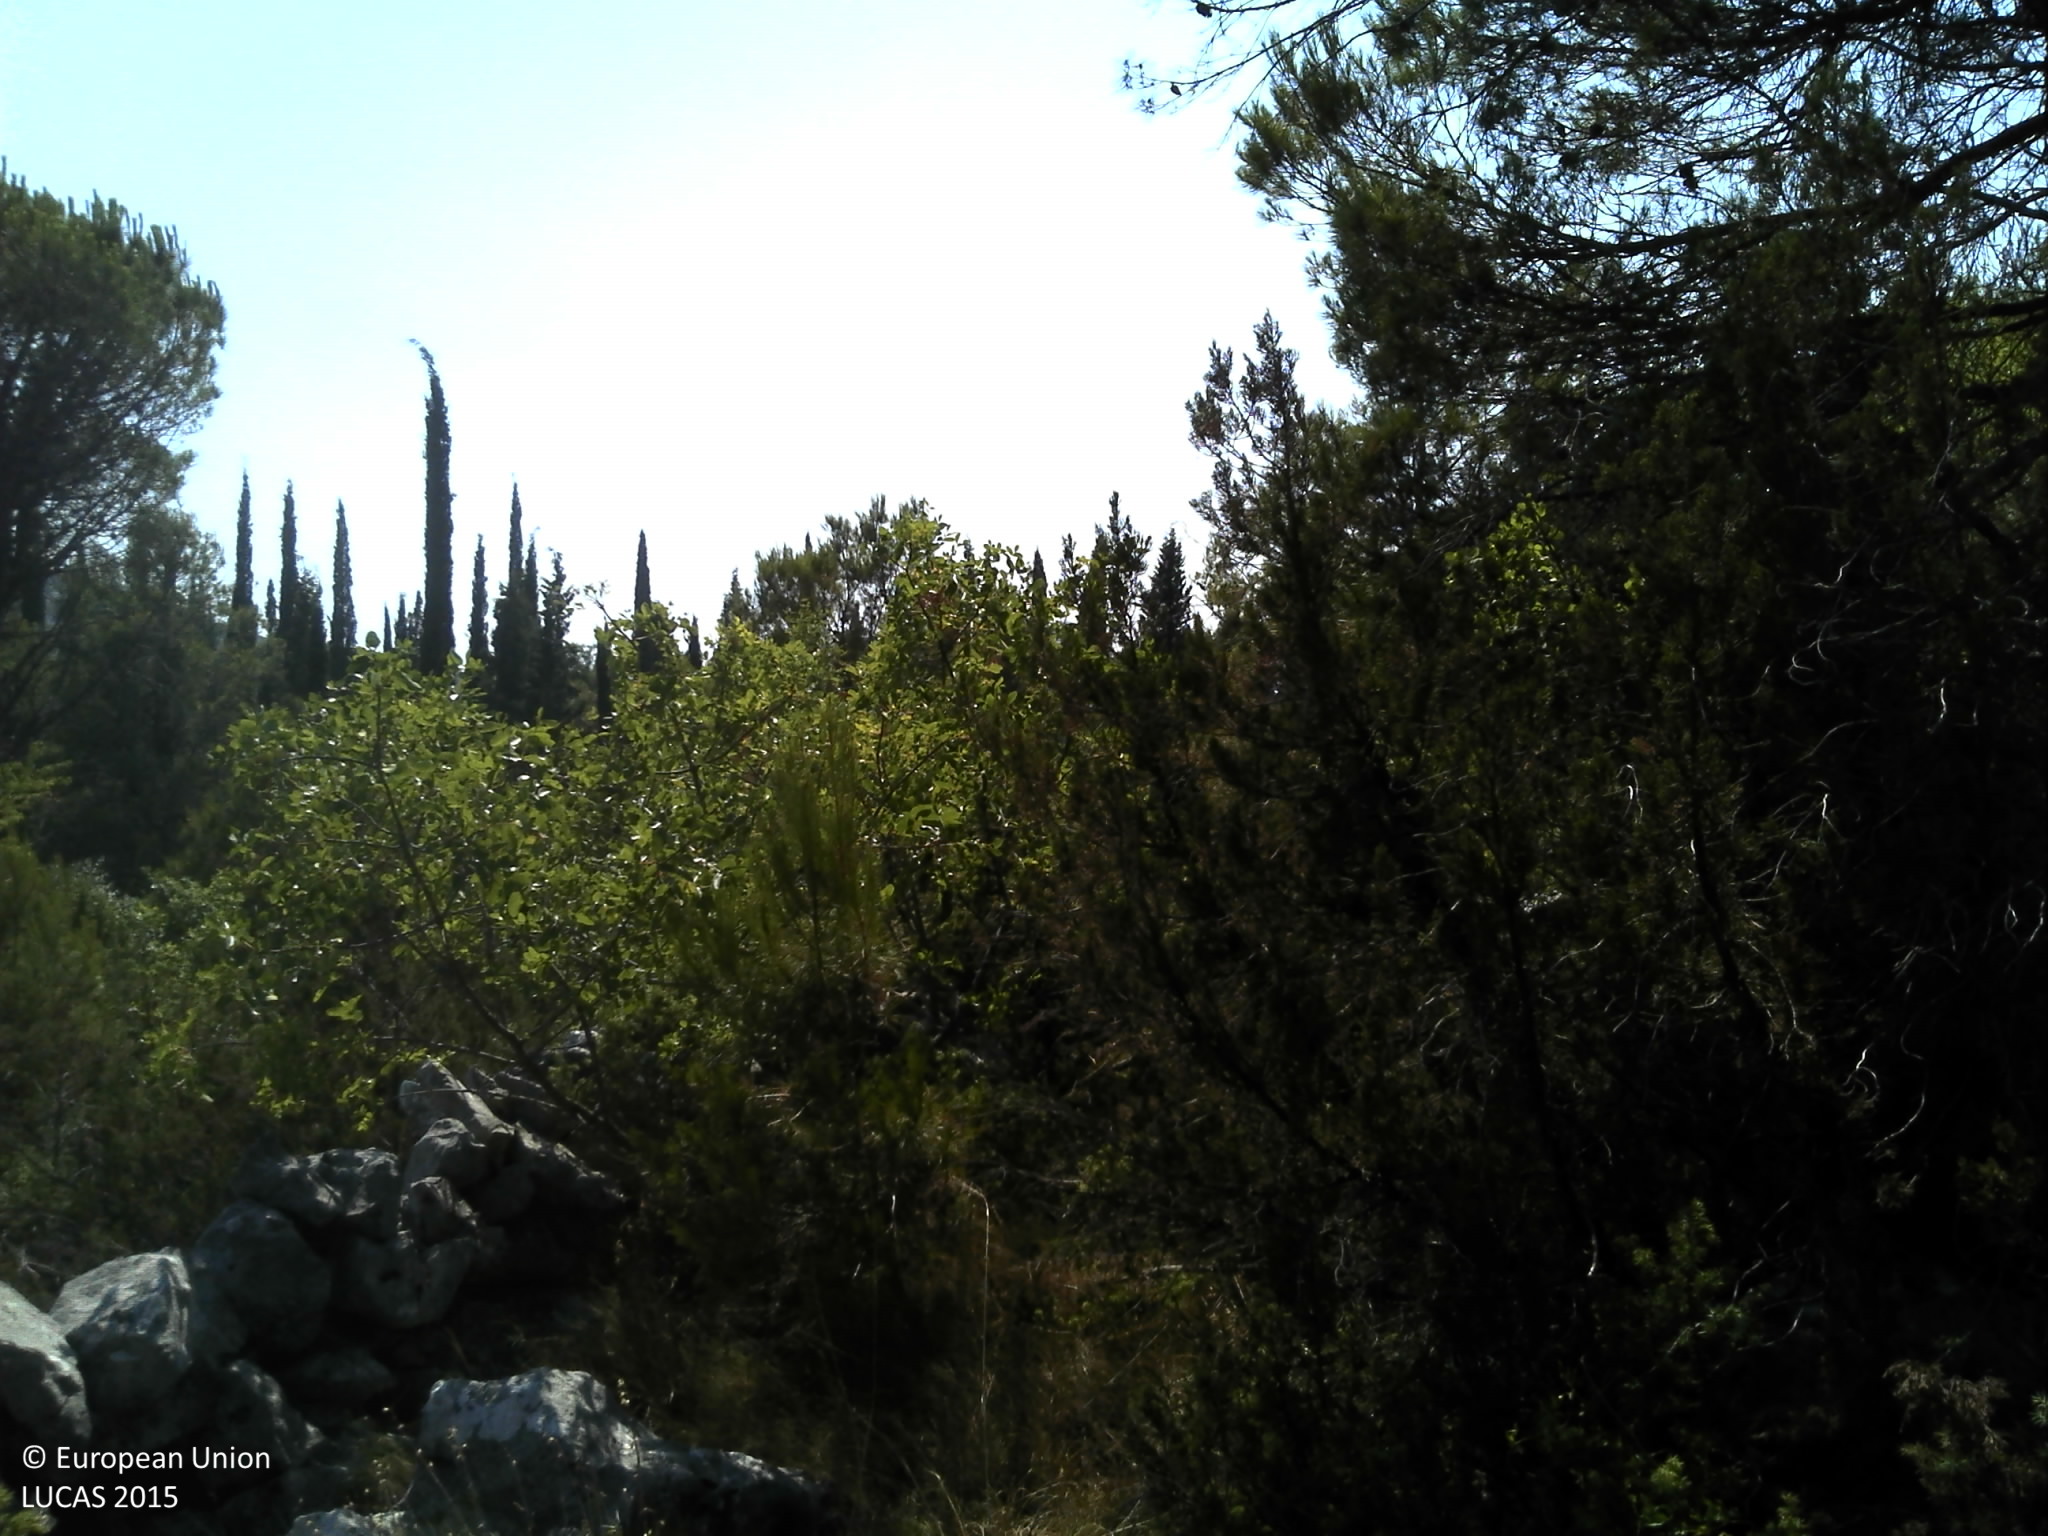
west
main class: Woodland
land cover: Pine dominated mixed woodland
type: coniferous forest of the mediterranean region
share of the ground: 50 - 75 %
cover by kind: coniferous forest trees 40 %, shrubs 25 %, broadleaved forest trees 20 %, unconsolidated bare surface 15 %
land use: Semi-natural and natural areas not in use
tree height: > 5 m
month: July
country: HR
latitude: 42.9050
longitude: 17.6944
